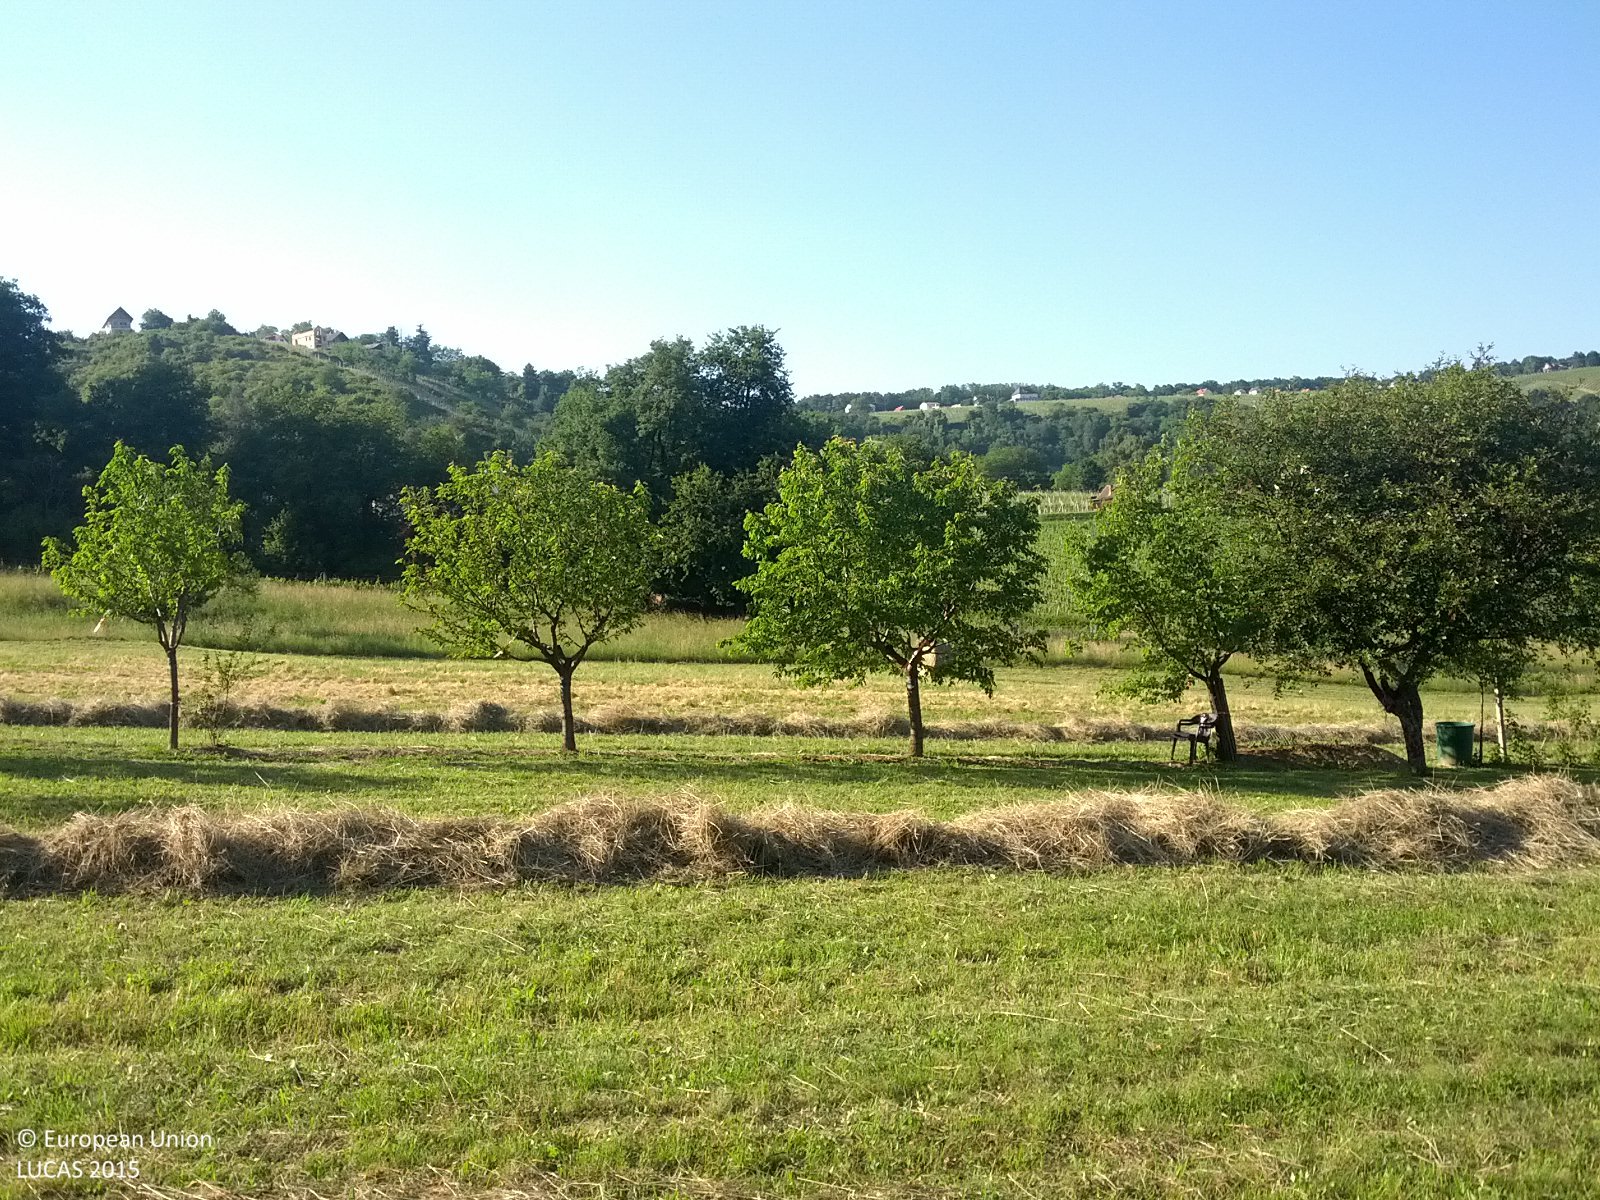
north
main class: Grassland
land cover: Grassland without tree/shrub cover
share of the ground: > 75 %
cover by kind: herbaceous plants 100 %
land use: Agriculture (excluding fallow land and kitchen gardens)
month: June
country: AT
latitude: 47.1888
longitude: 16.4035
